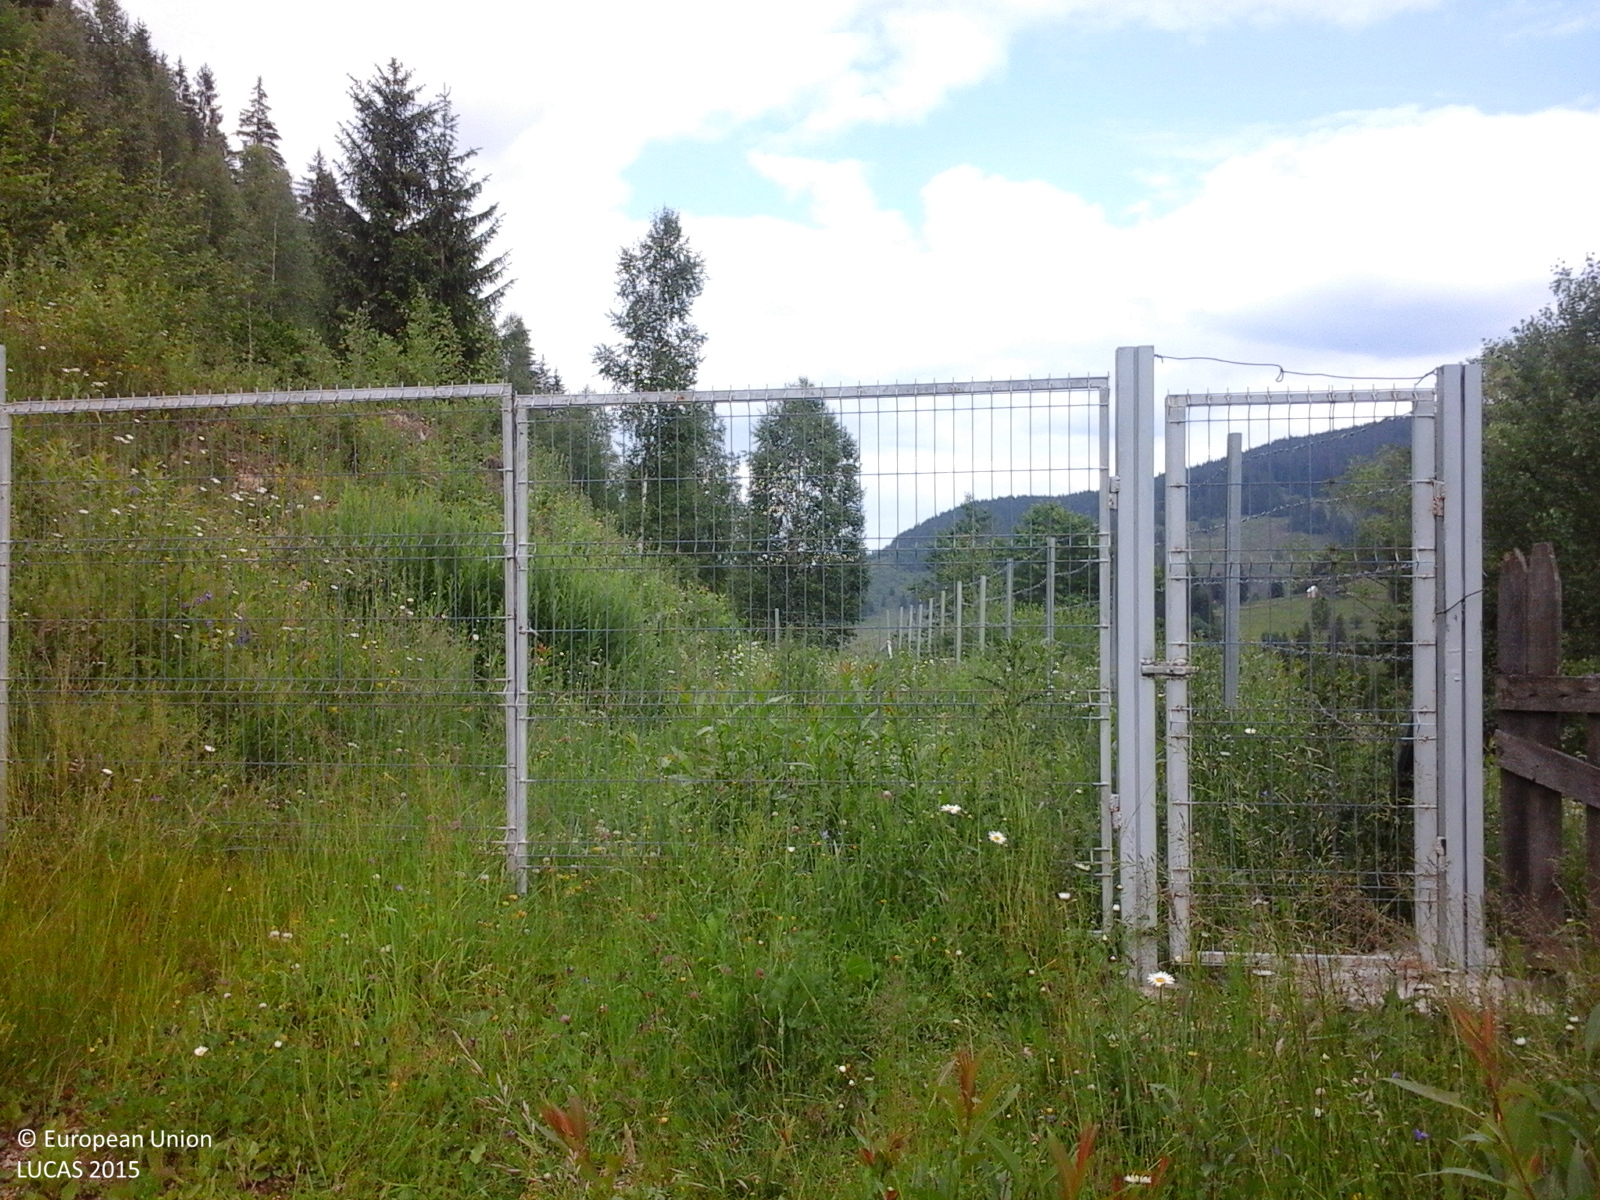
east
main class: Grassland
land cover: Grassland with sparse tree/shrub cover
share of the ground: > 75 %
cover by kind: herbaceous plants 95 %, broadleaved forest trees 5 %
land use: Agriculture (excluding fallow land and kitchen gardens)
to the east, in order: Grassland with sparse tree/shrub cover; Fences; Grassland with sparse tree/shrub cover; Fences; Grassland with sparse tree/shrub cover; Other mixed woodland
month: June
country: RO
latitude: 47.5391
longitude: 25.3779
